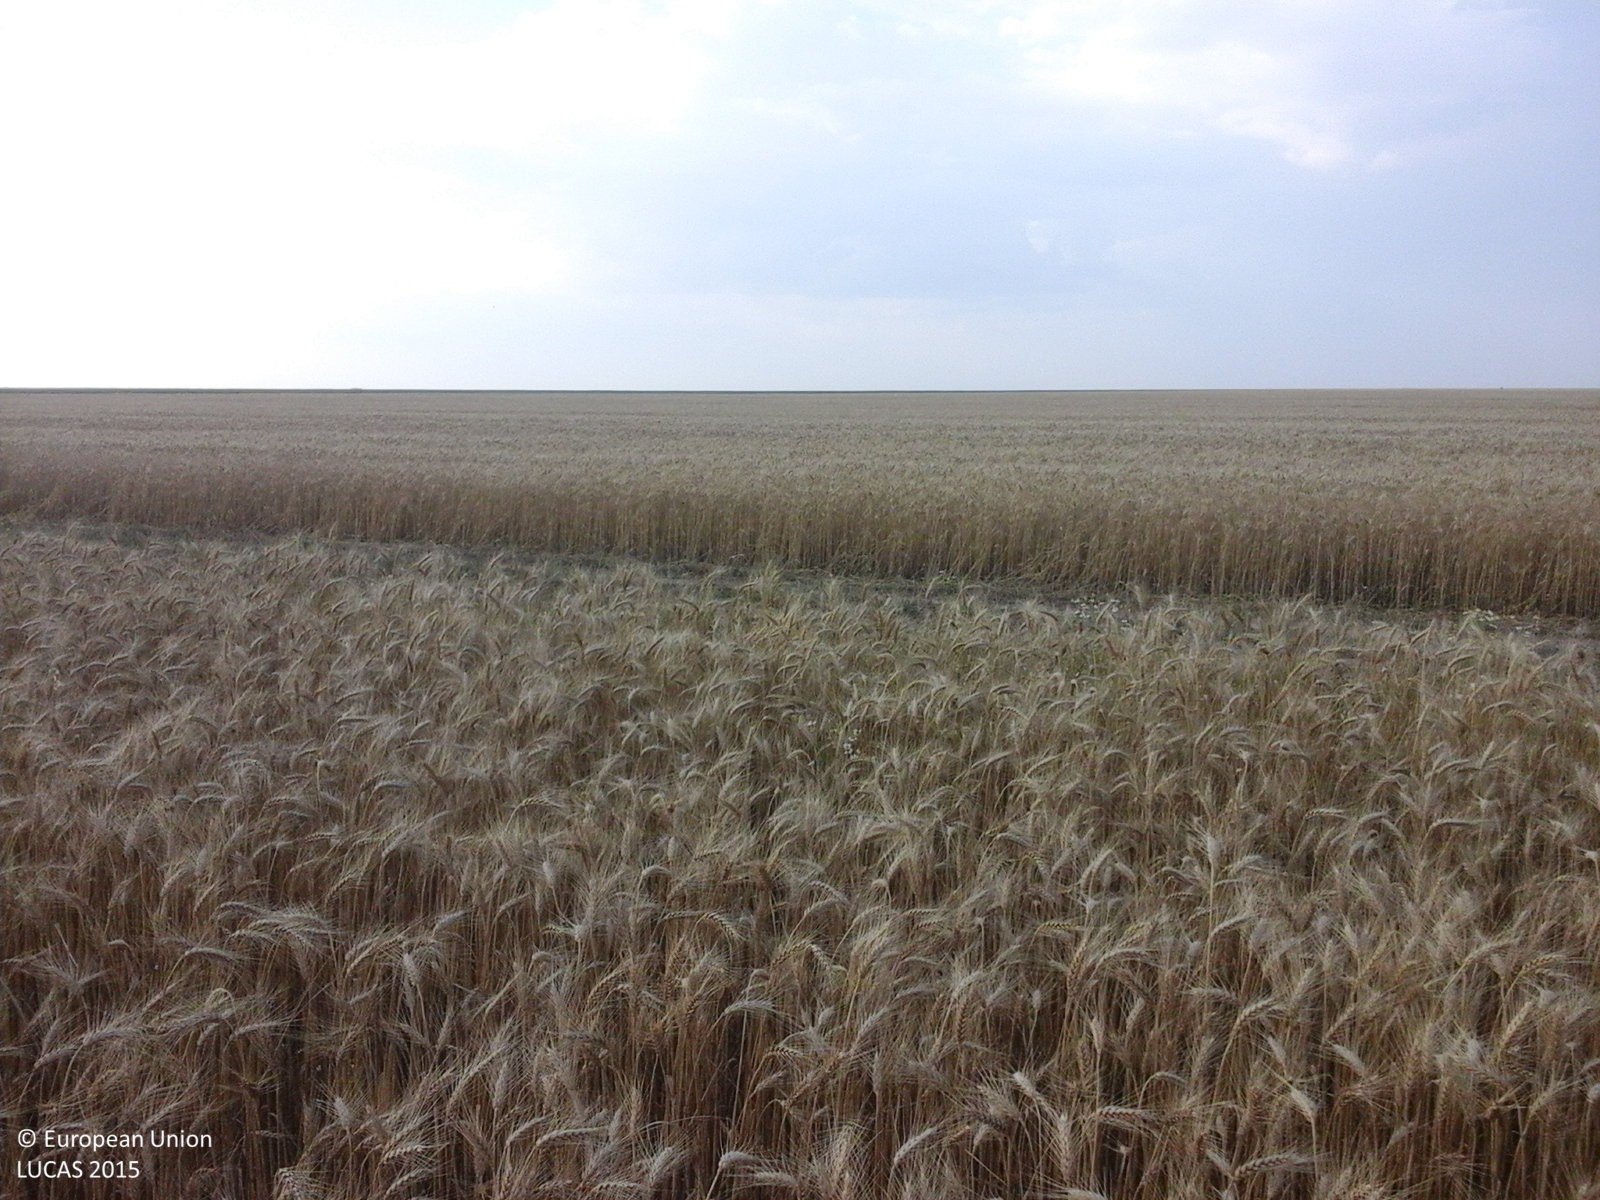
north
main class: Cropland
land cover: Common wheat
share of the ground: > 75 %
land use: Agriculture (excluding fallow land and kitchen gardens)
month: July
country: RO
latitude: 44.1941
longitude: 25.9258
